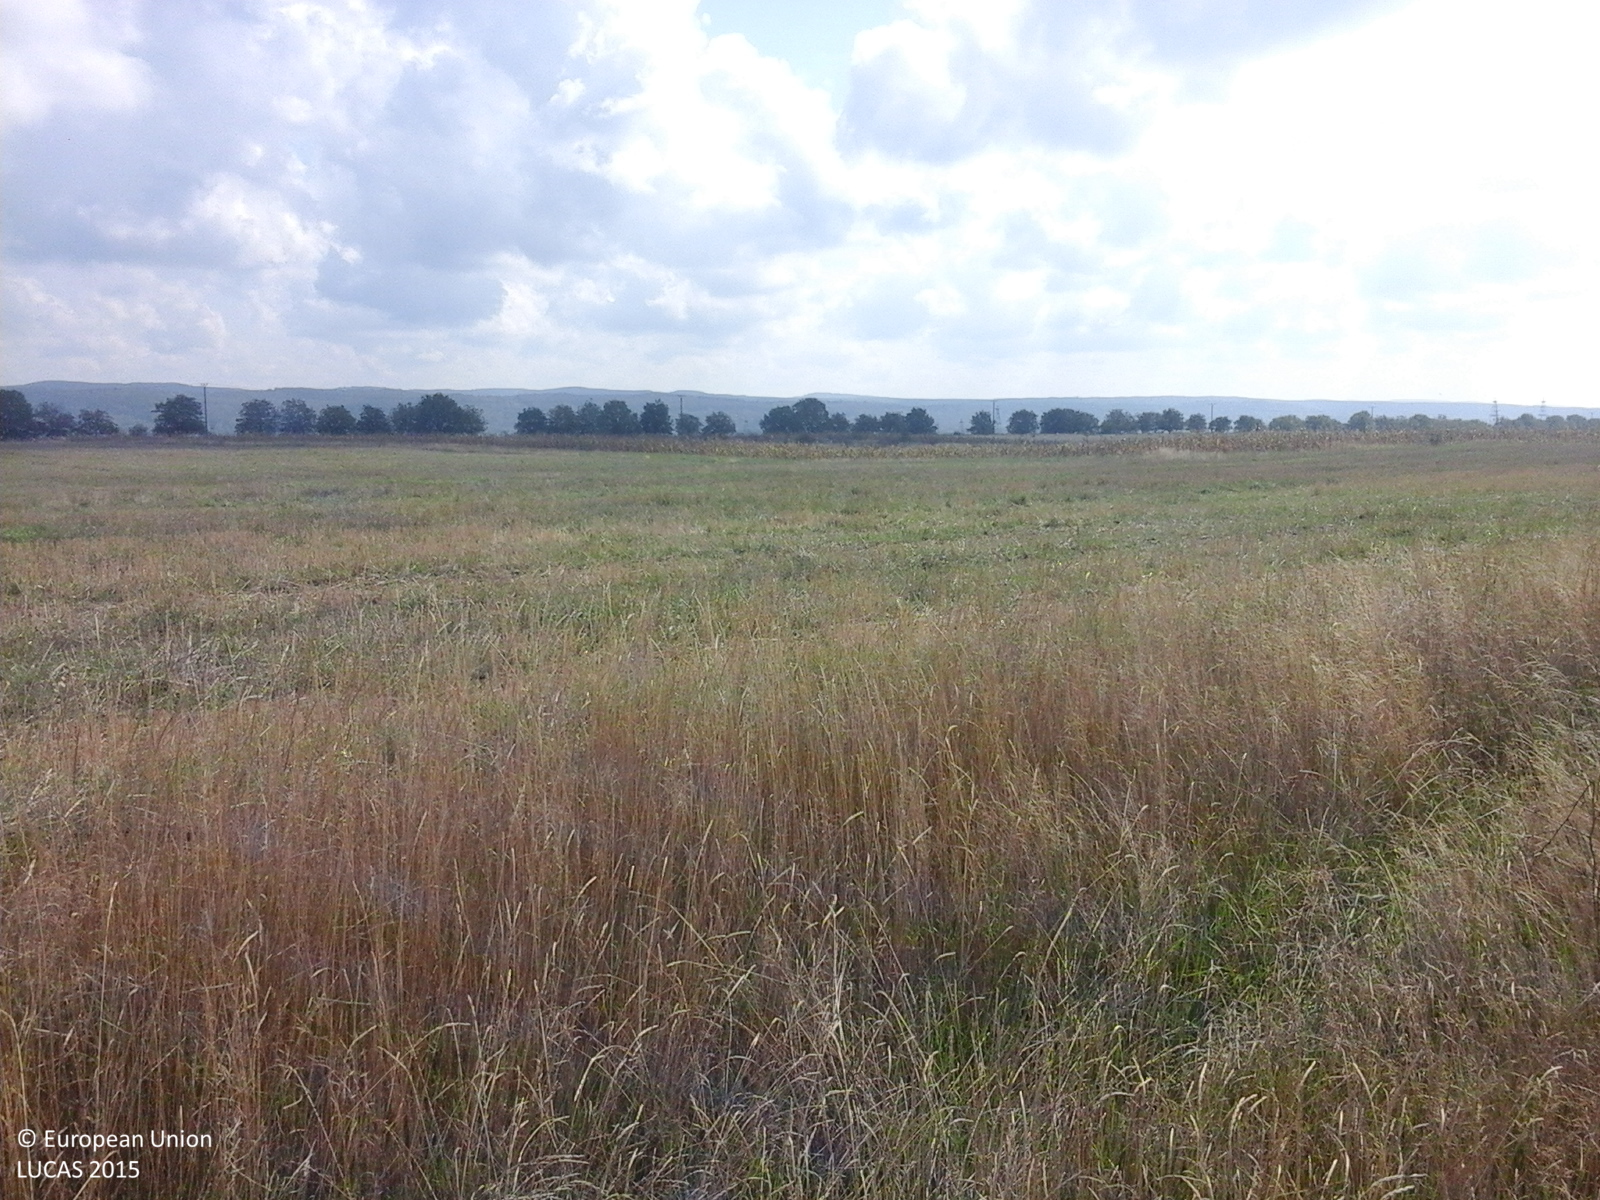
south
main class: Grassland
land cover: Spontaneously vegetated surfaces
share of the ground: > 75 %
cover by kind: herbaceous plants 100 %
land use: Fallow land
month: September
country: RO
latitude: 45.0278
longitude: 23.5499
